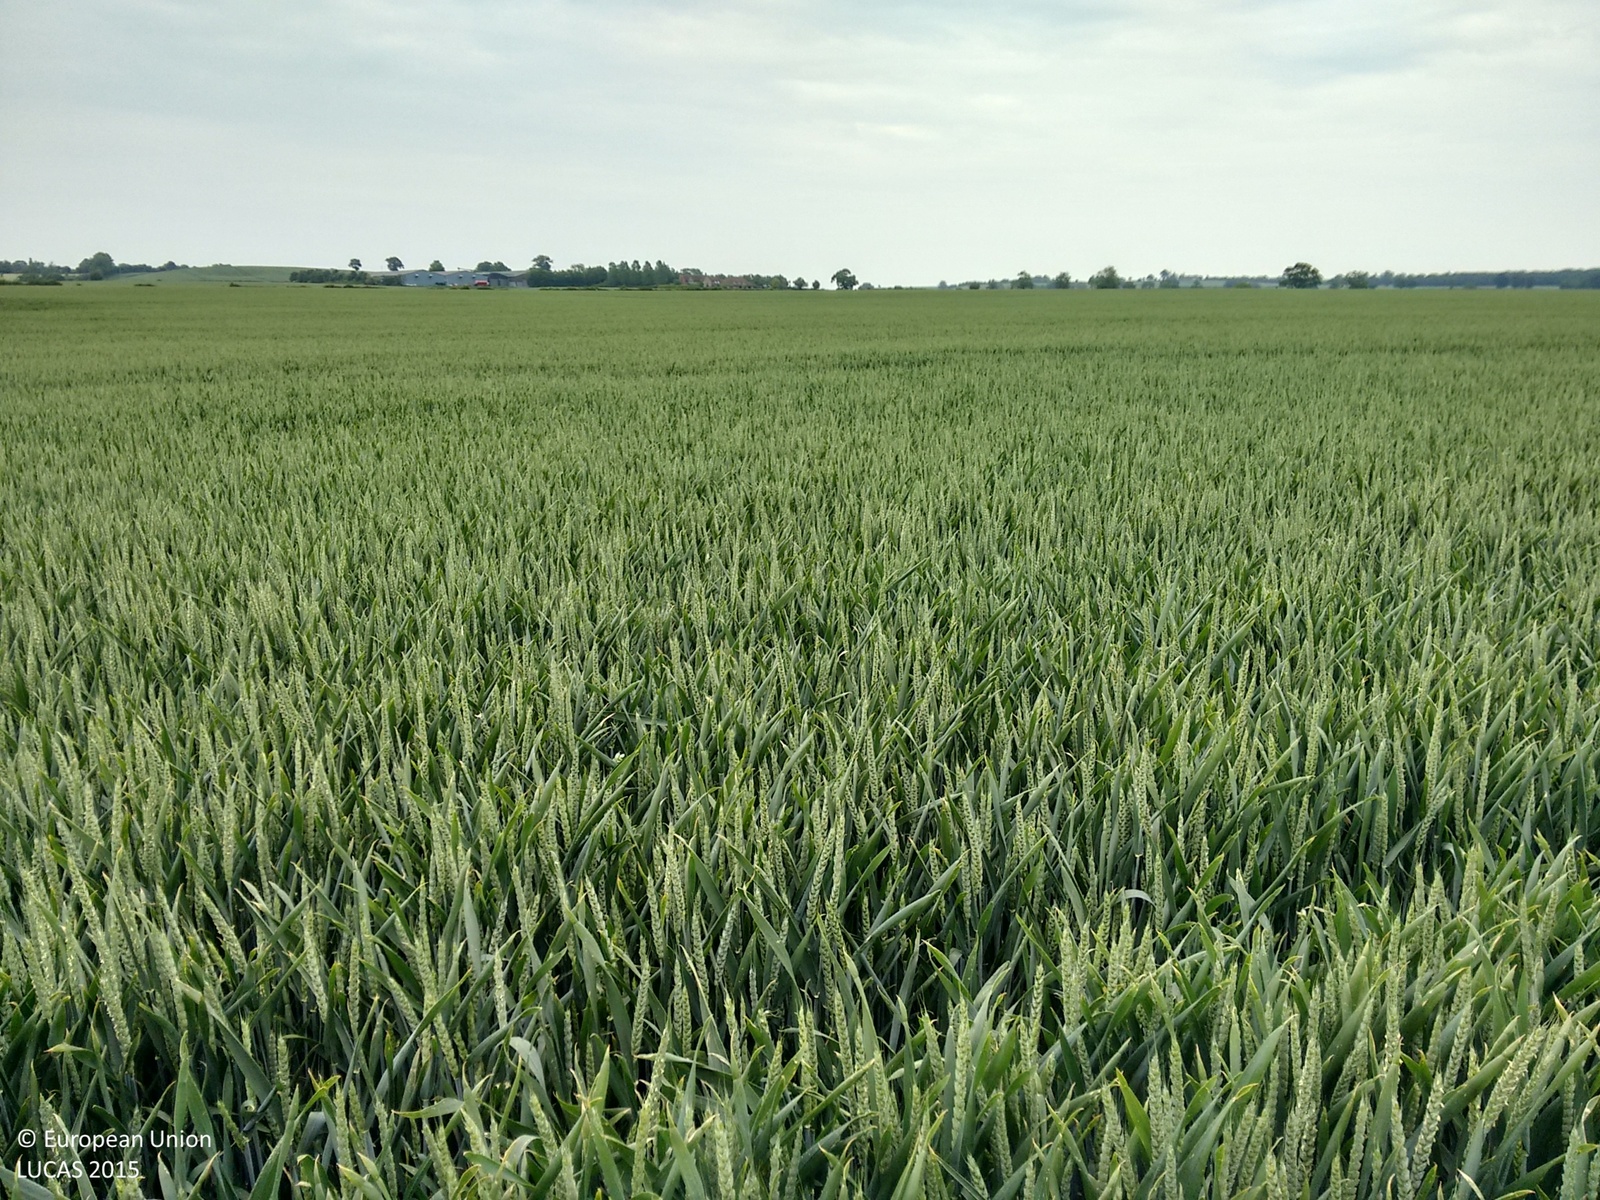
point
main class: Cropland
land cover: Common wheat
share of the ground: > 75 %
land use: Agriculture (excluding fallow land and kitchen gardens)
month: June
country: GB
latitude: 52.2184
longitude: -1.6607
